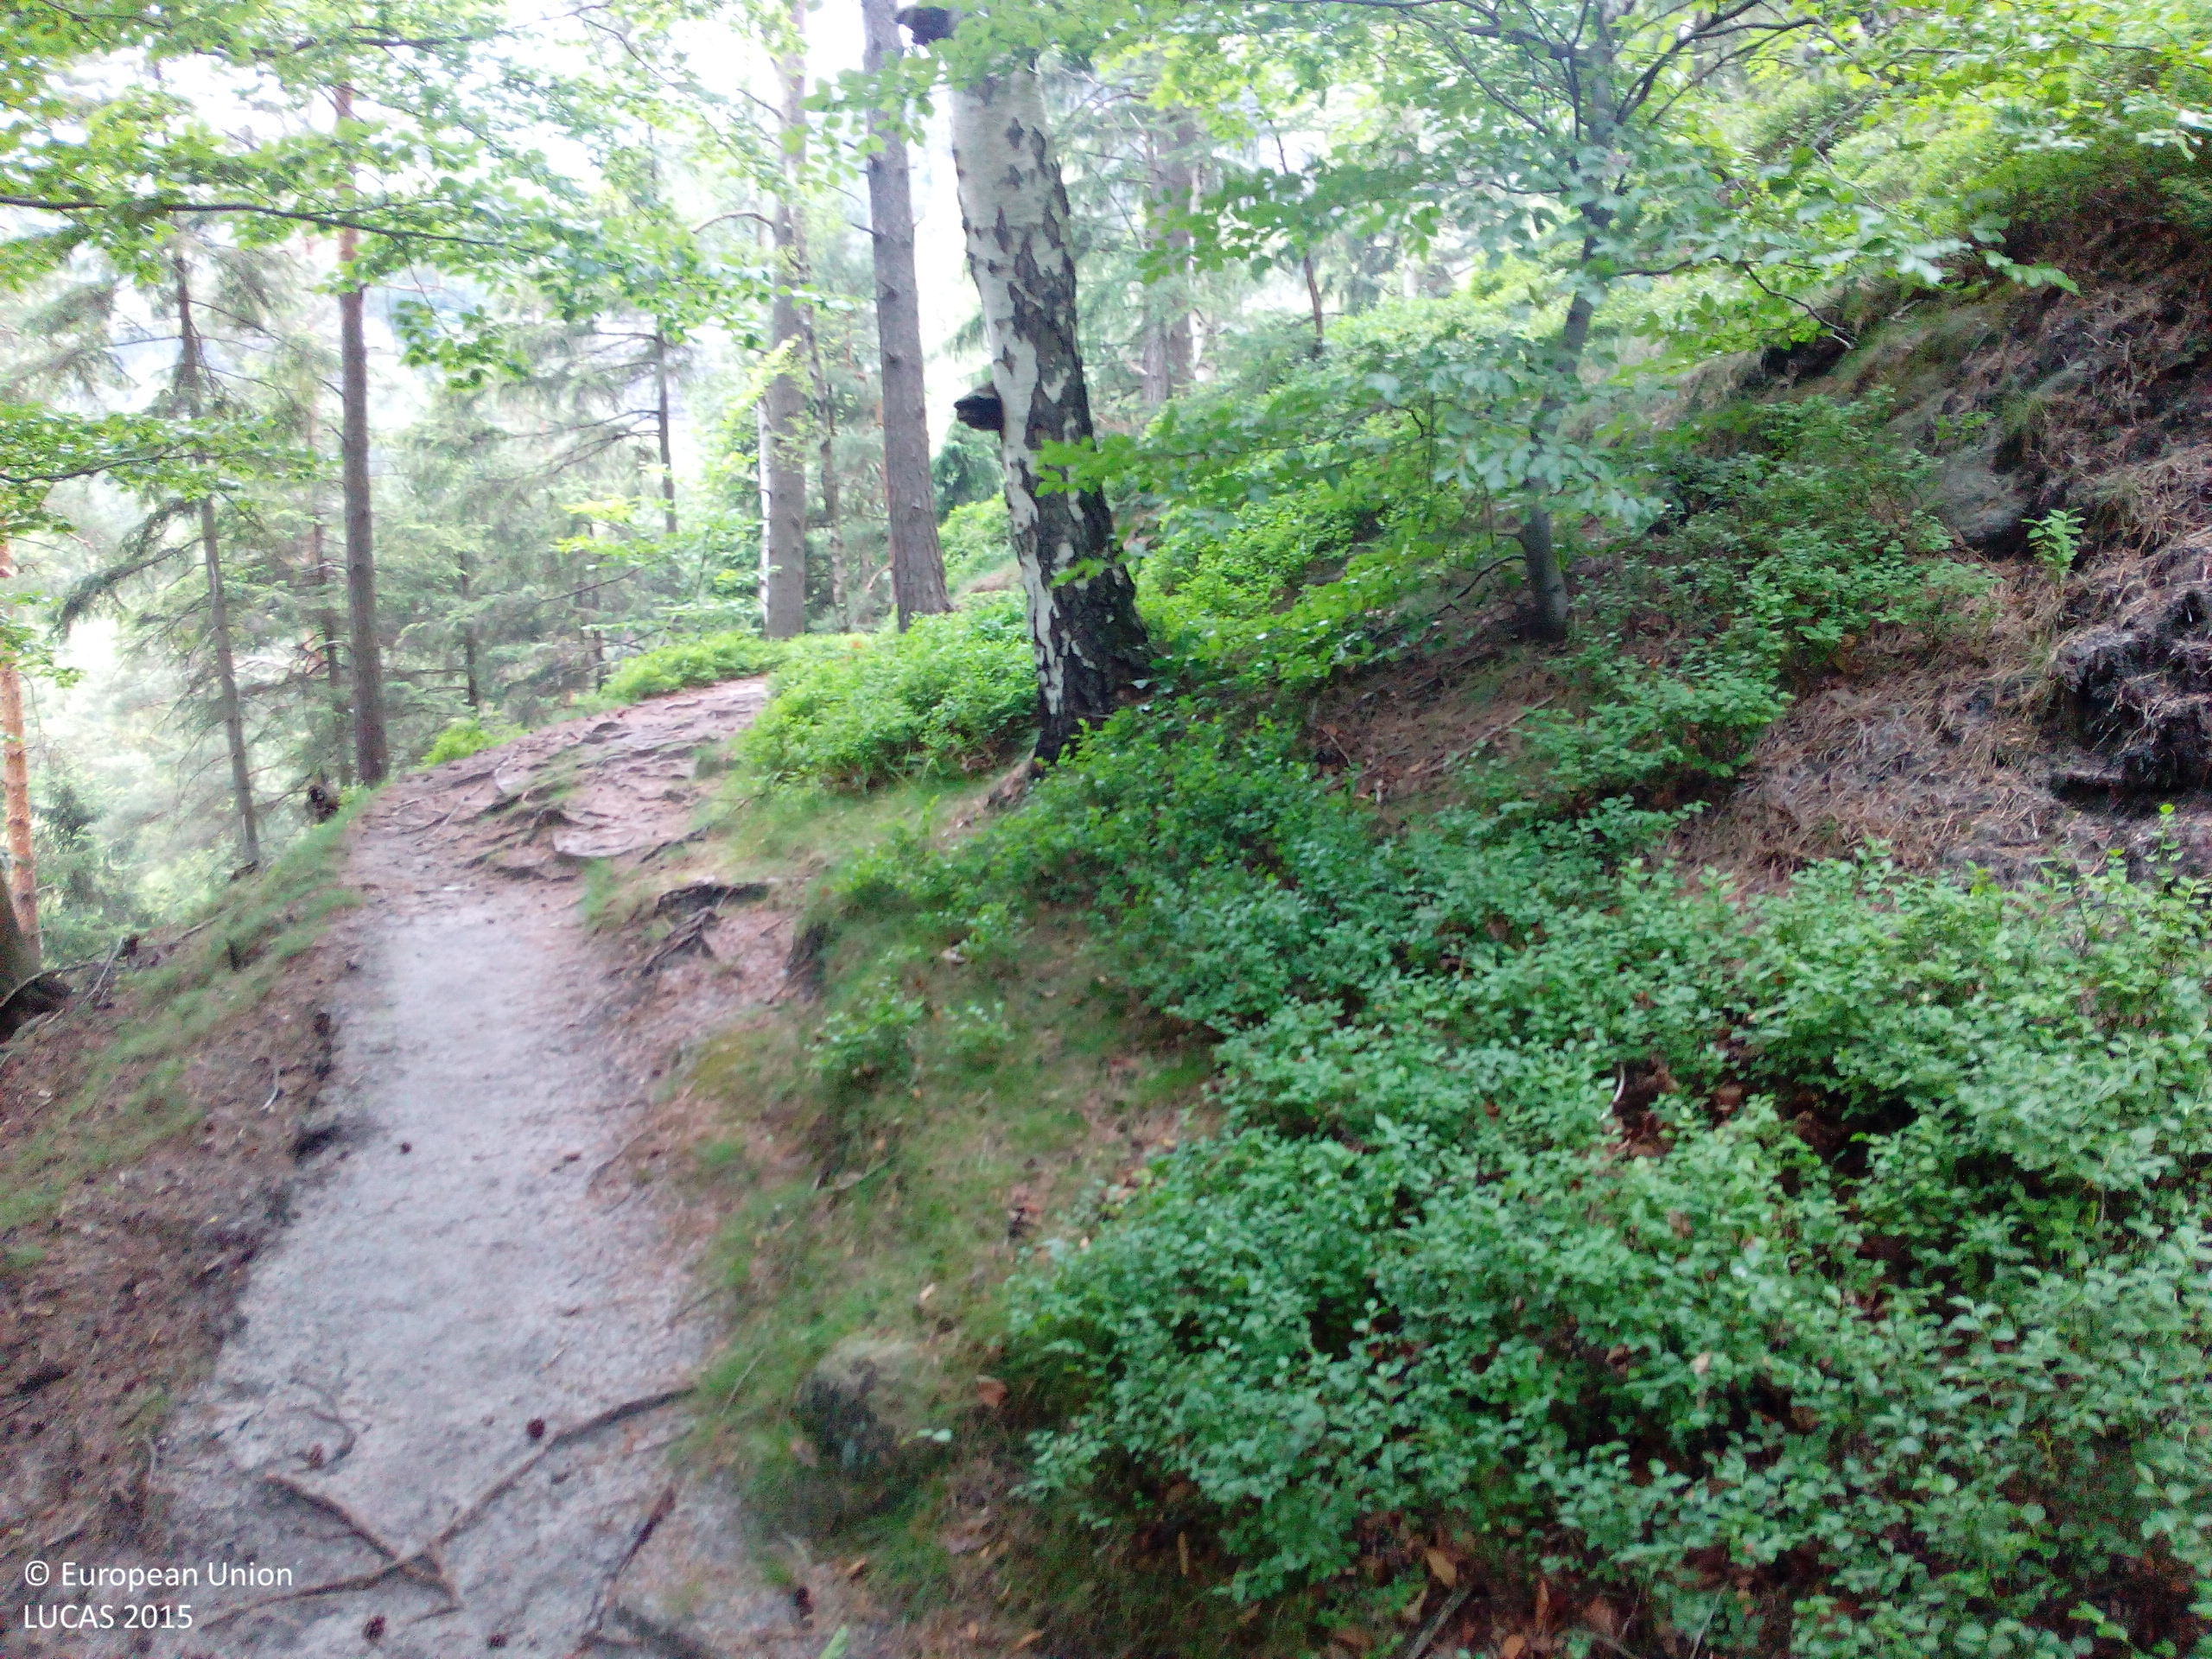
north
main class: Woodland
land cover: Pine dominated mixed woodland
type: hemiboreal forest and nemoral coniferous forest and mixed broadleaved-coniferous forest
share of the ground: > 75 %
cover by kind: coniferous forest trees 60 %, broadleaved forest trees 40 %
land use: Forestry
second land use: Amenities, museums, leisure
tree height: > 5 m
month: June
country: DE
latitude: 50.8951
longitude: 14.3094
